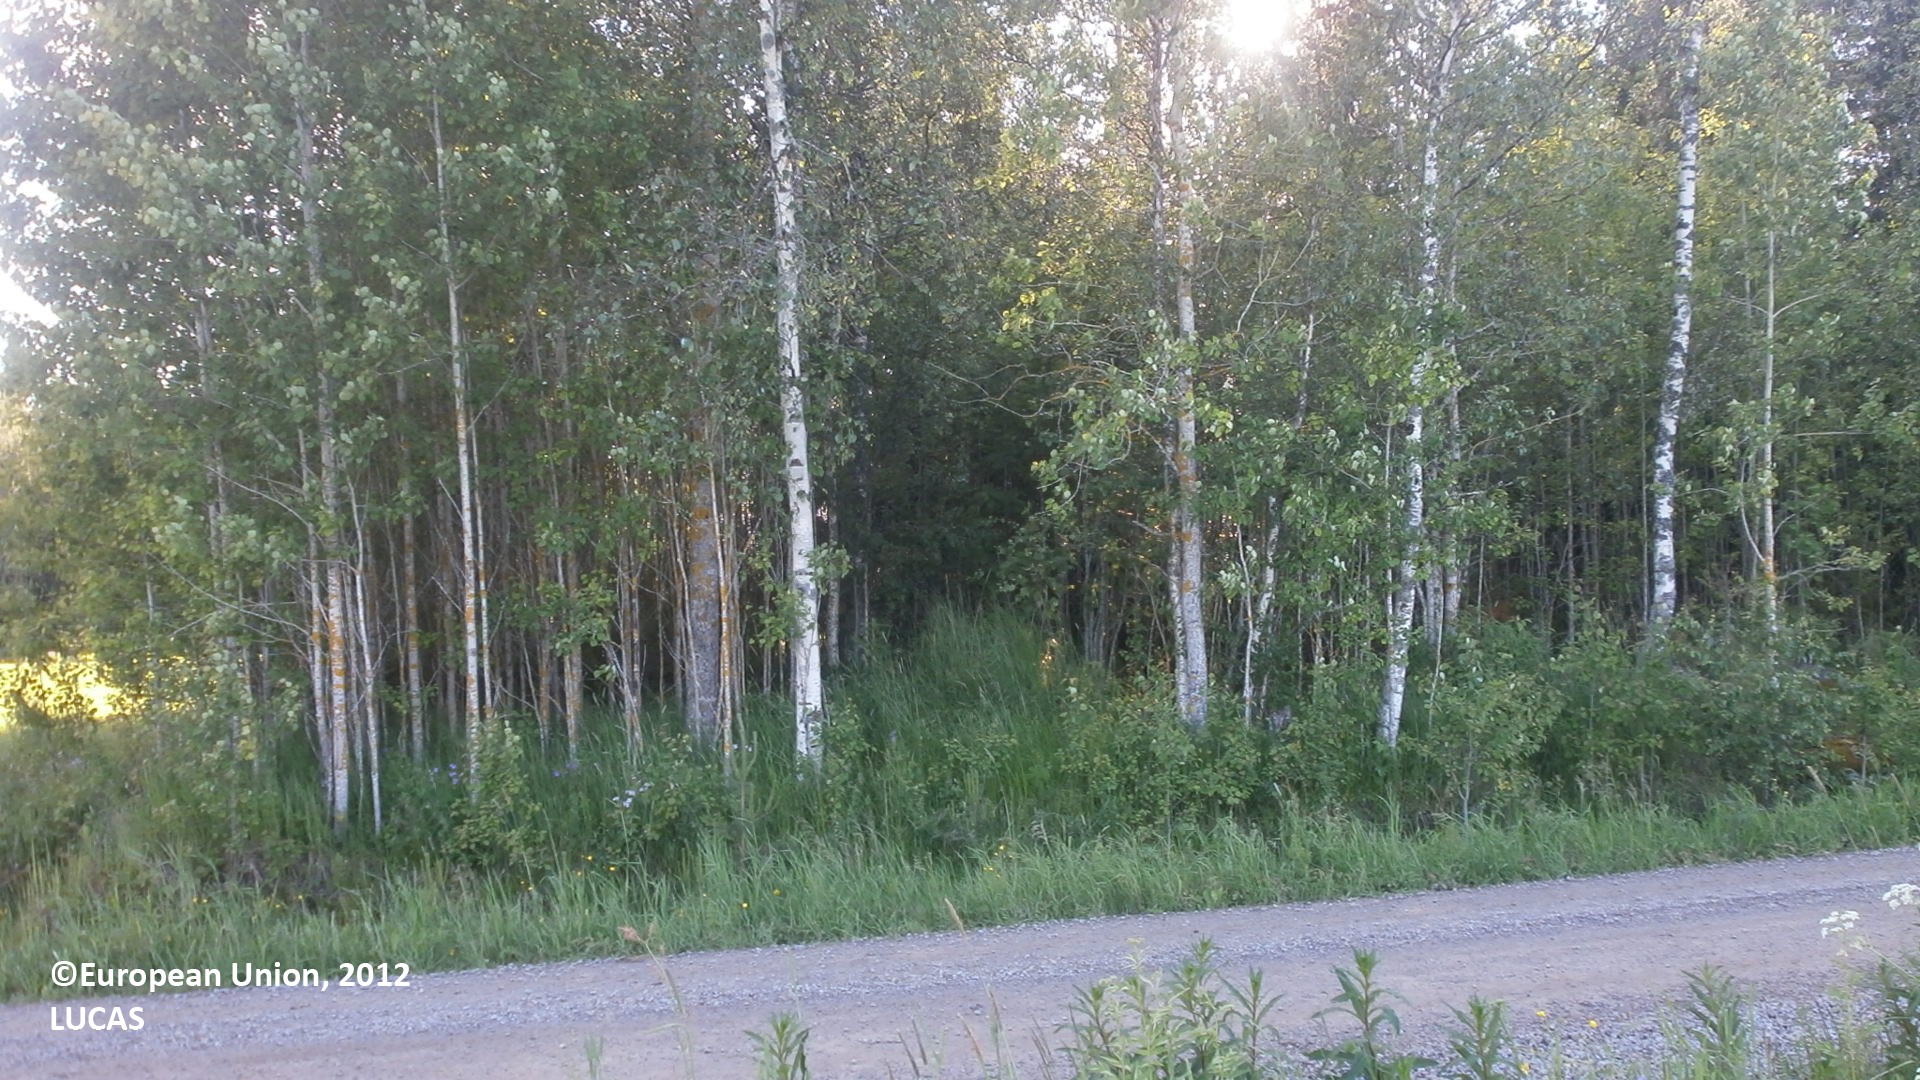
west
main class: Cropland
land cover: Barley
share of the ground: 50 - 75 %
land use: Agriculture (excluding fallow land and kitchen gardens)
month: June
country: FI
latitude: 64.3960
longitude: 25.0344
